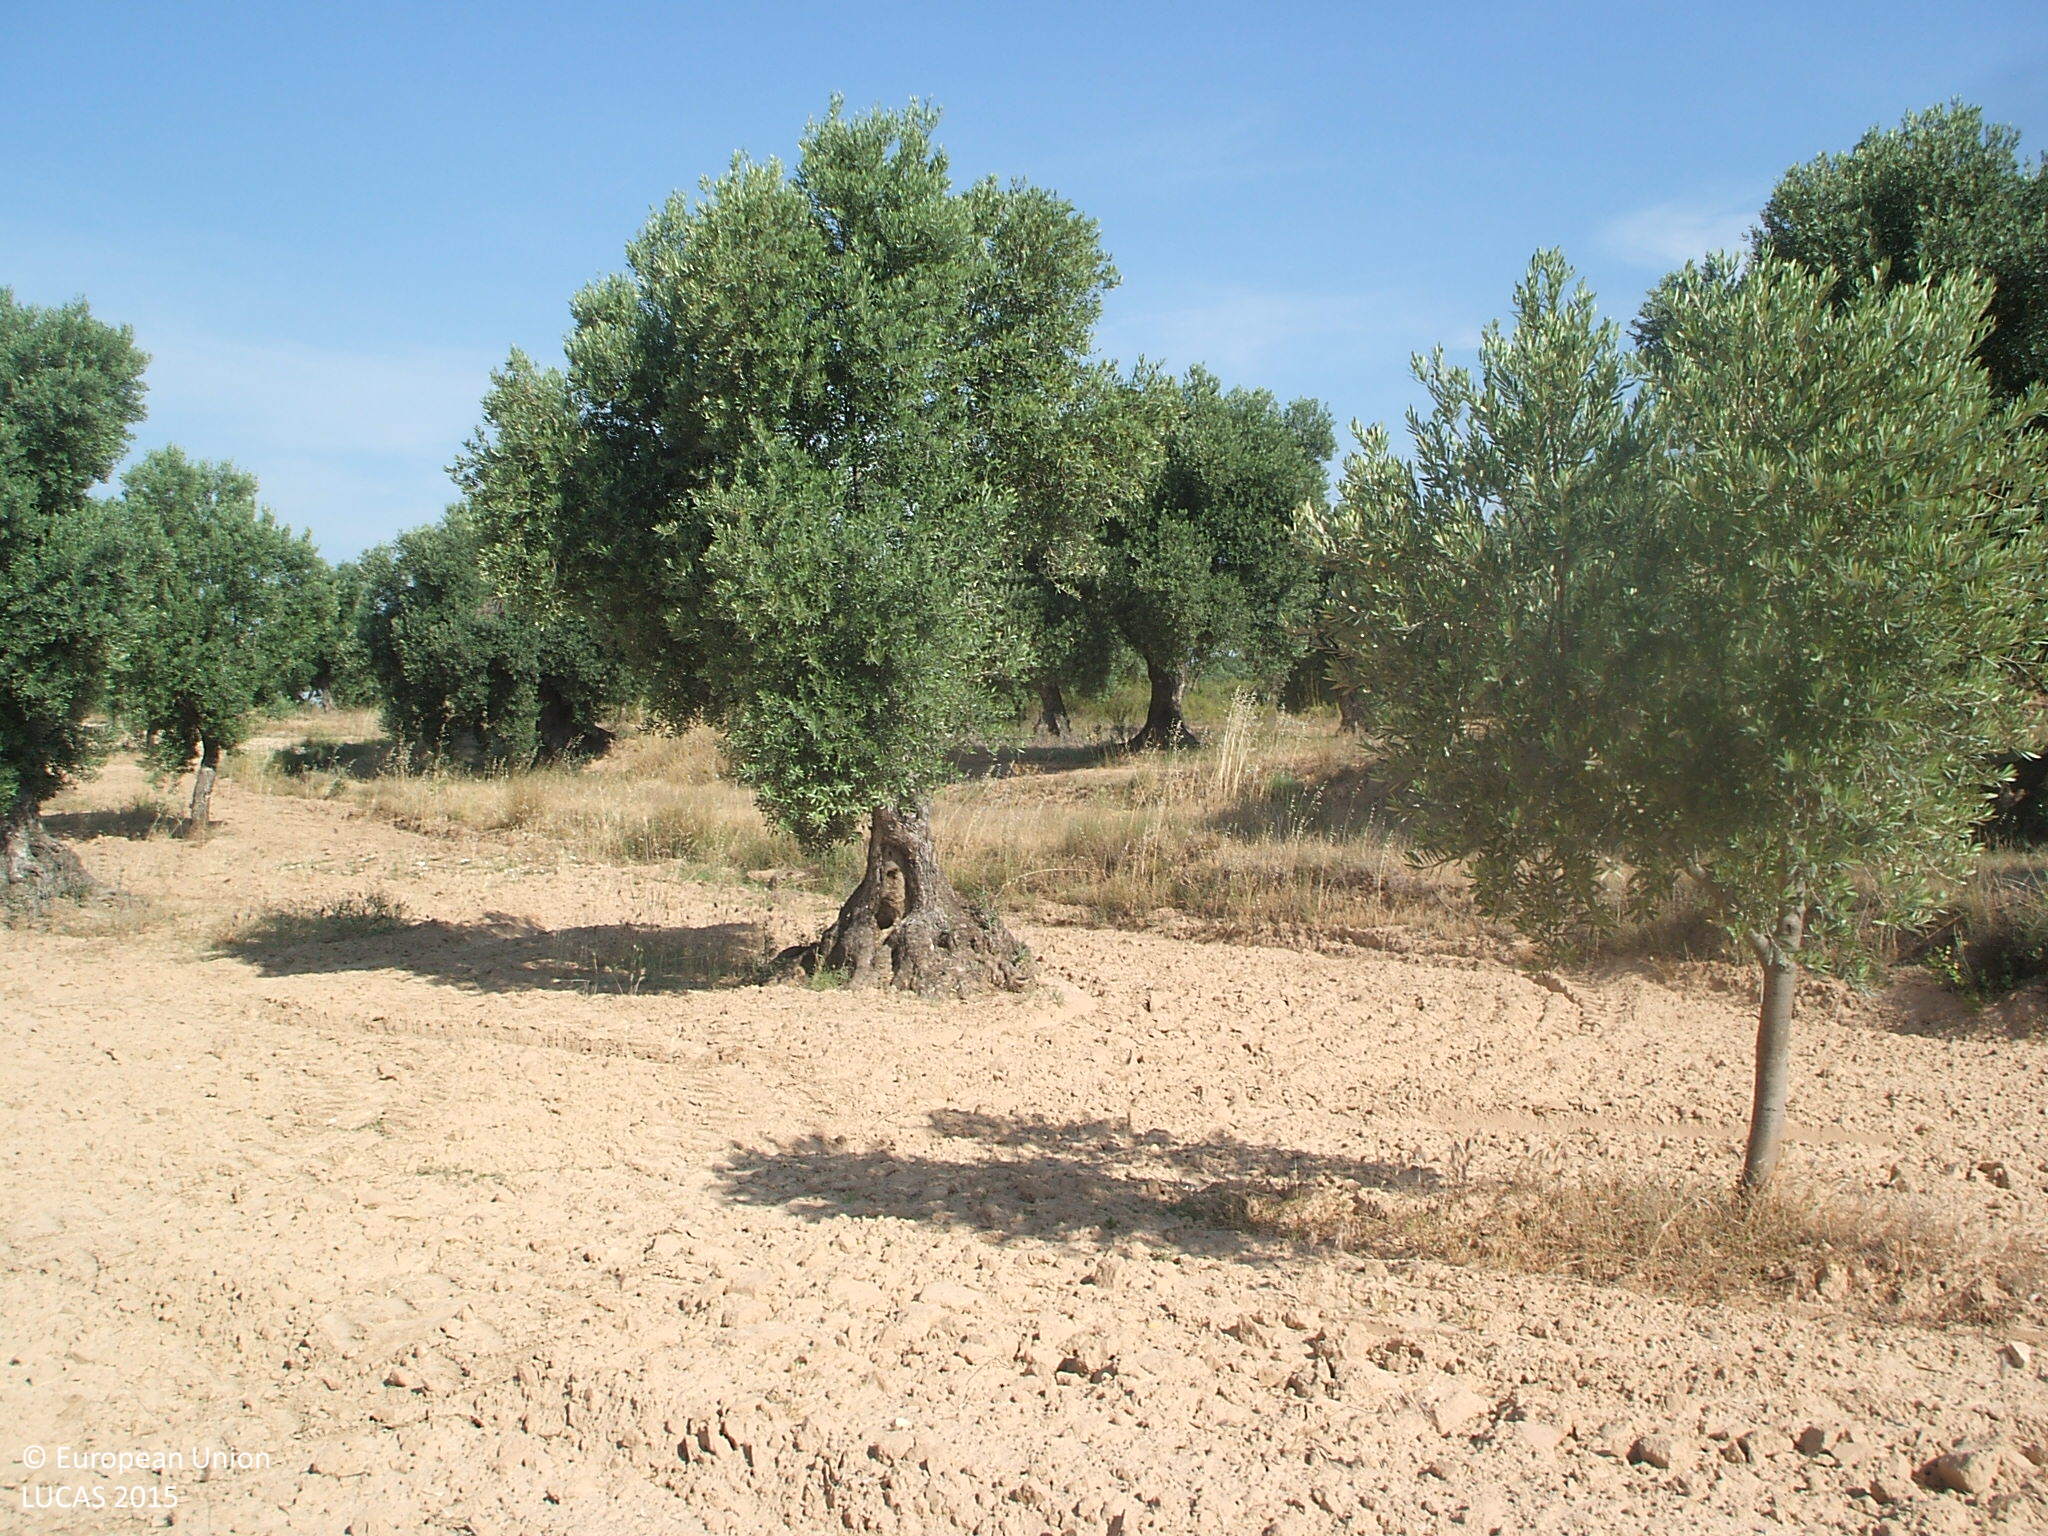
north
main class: Cropland
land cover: Olive groves
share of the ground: 10 - 25 %
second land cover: Other bare soil
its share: > 75 %
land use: Agriculture (excluding fallow land and kitchen gardens)
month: June
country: ES
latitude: 41.0452
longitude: 0.1516
